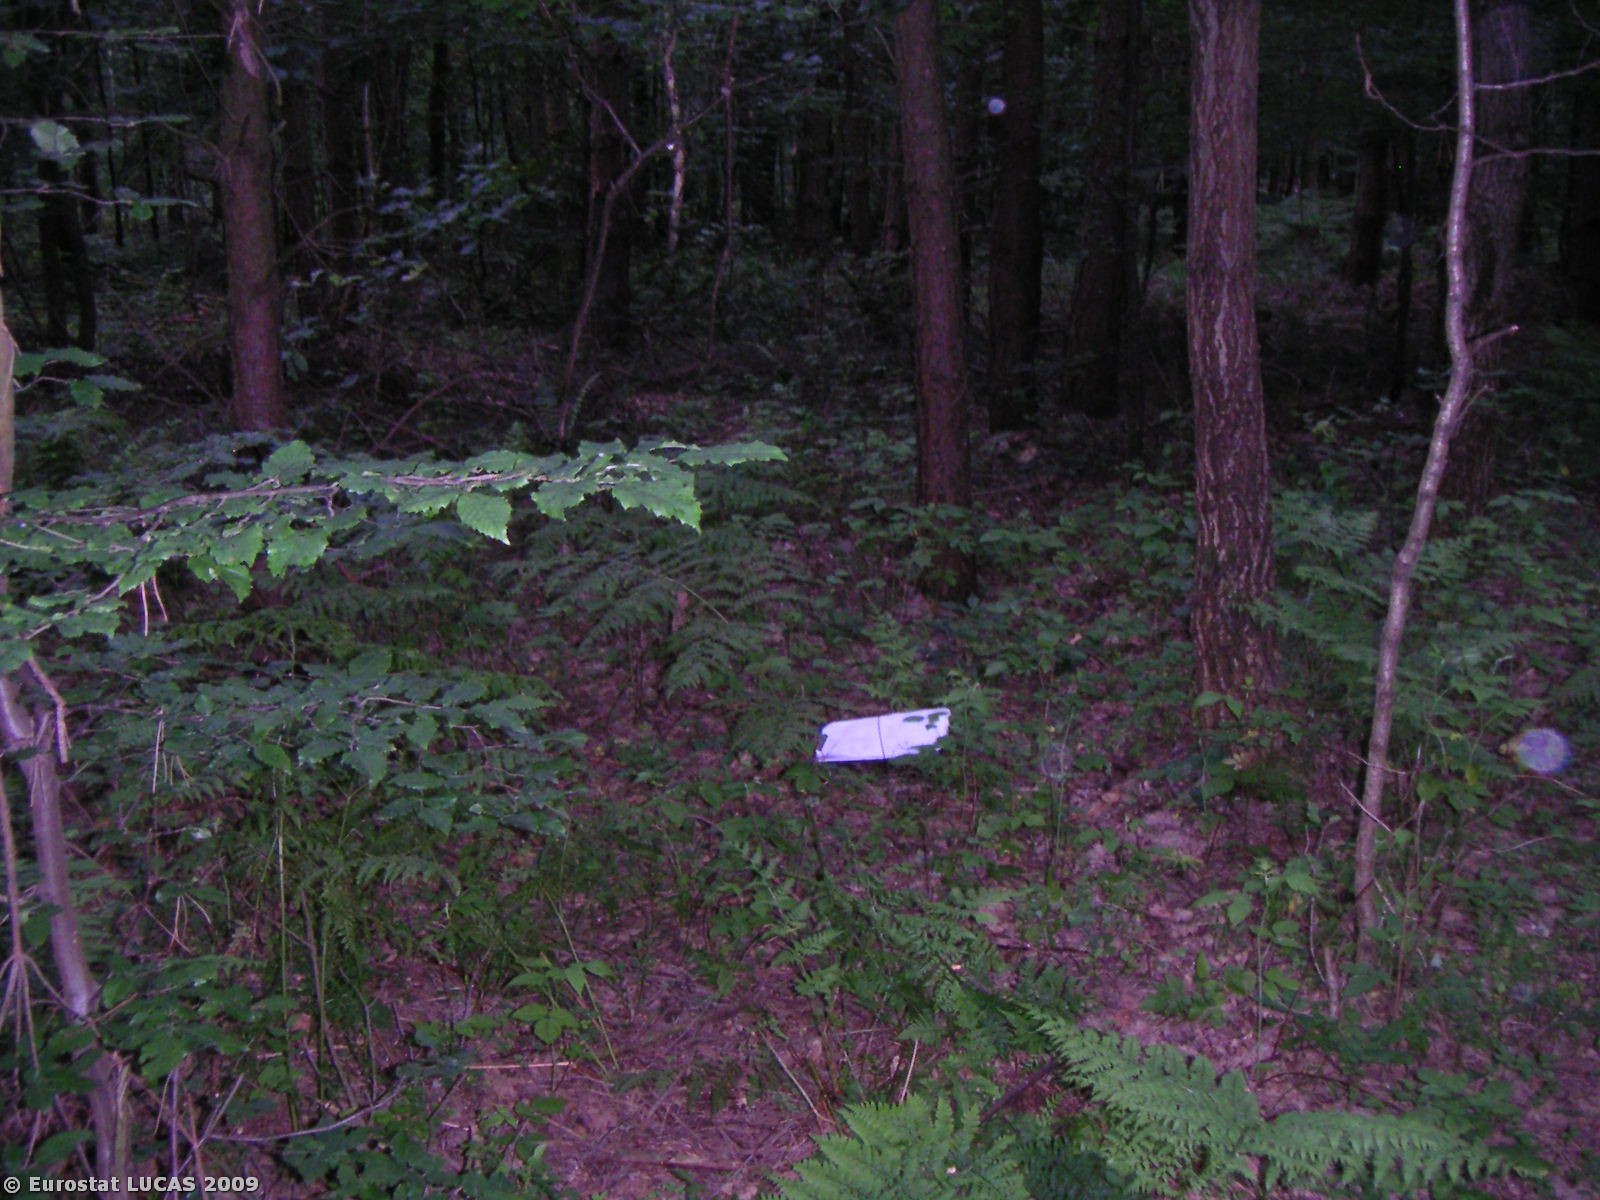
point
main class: Woodland
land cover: Coniferous woodland
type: hemiboreal forest and nemoral coniferous forest and mixed broadleaved-coniferous forest
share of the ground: > 75 %
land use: Forestry
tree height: > 5 m
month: July
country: PL
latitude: 50.5441
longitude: 19.7529
